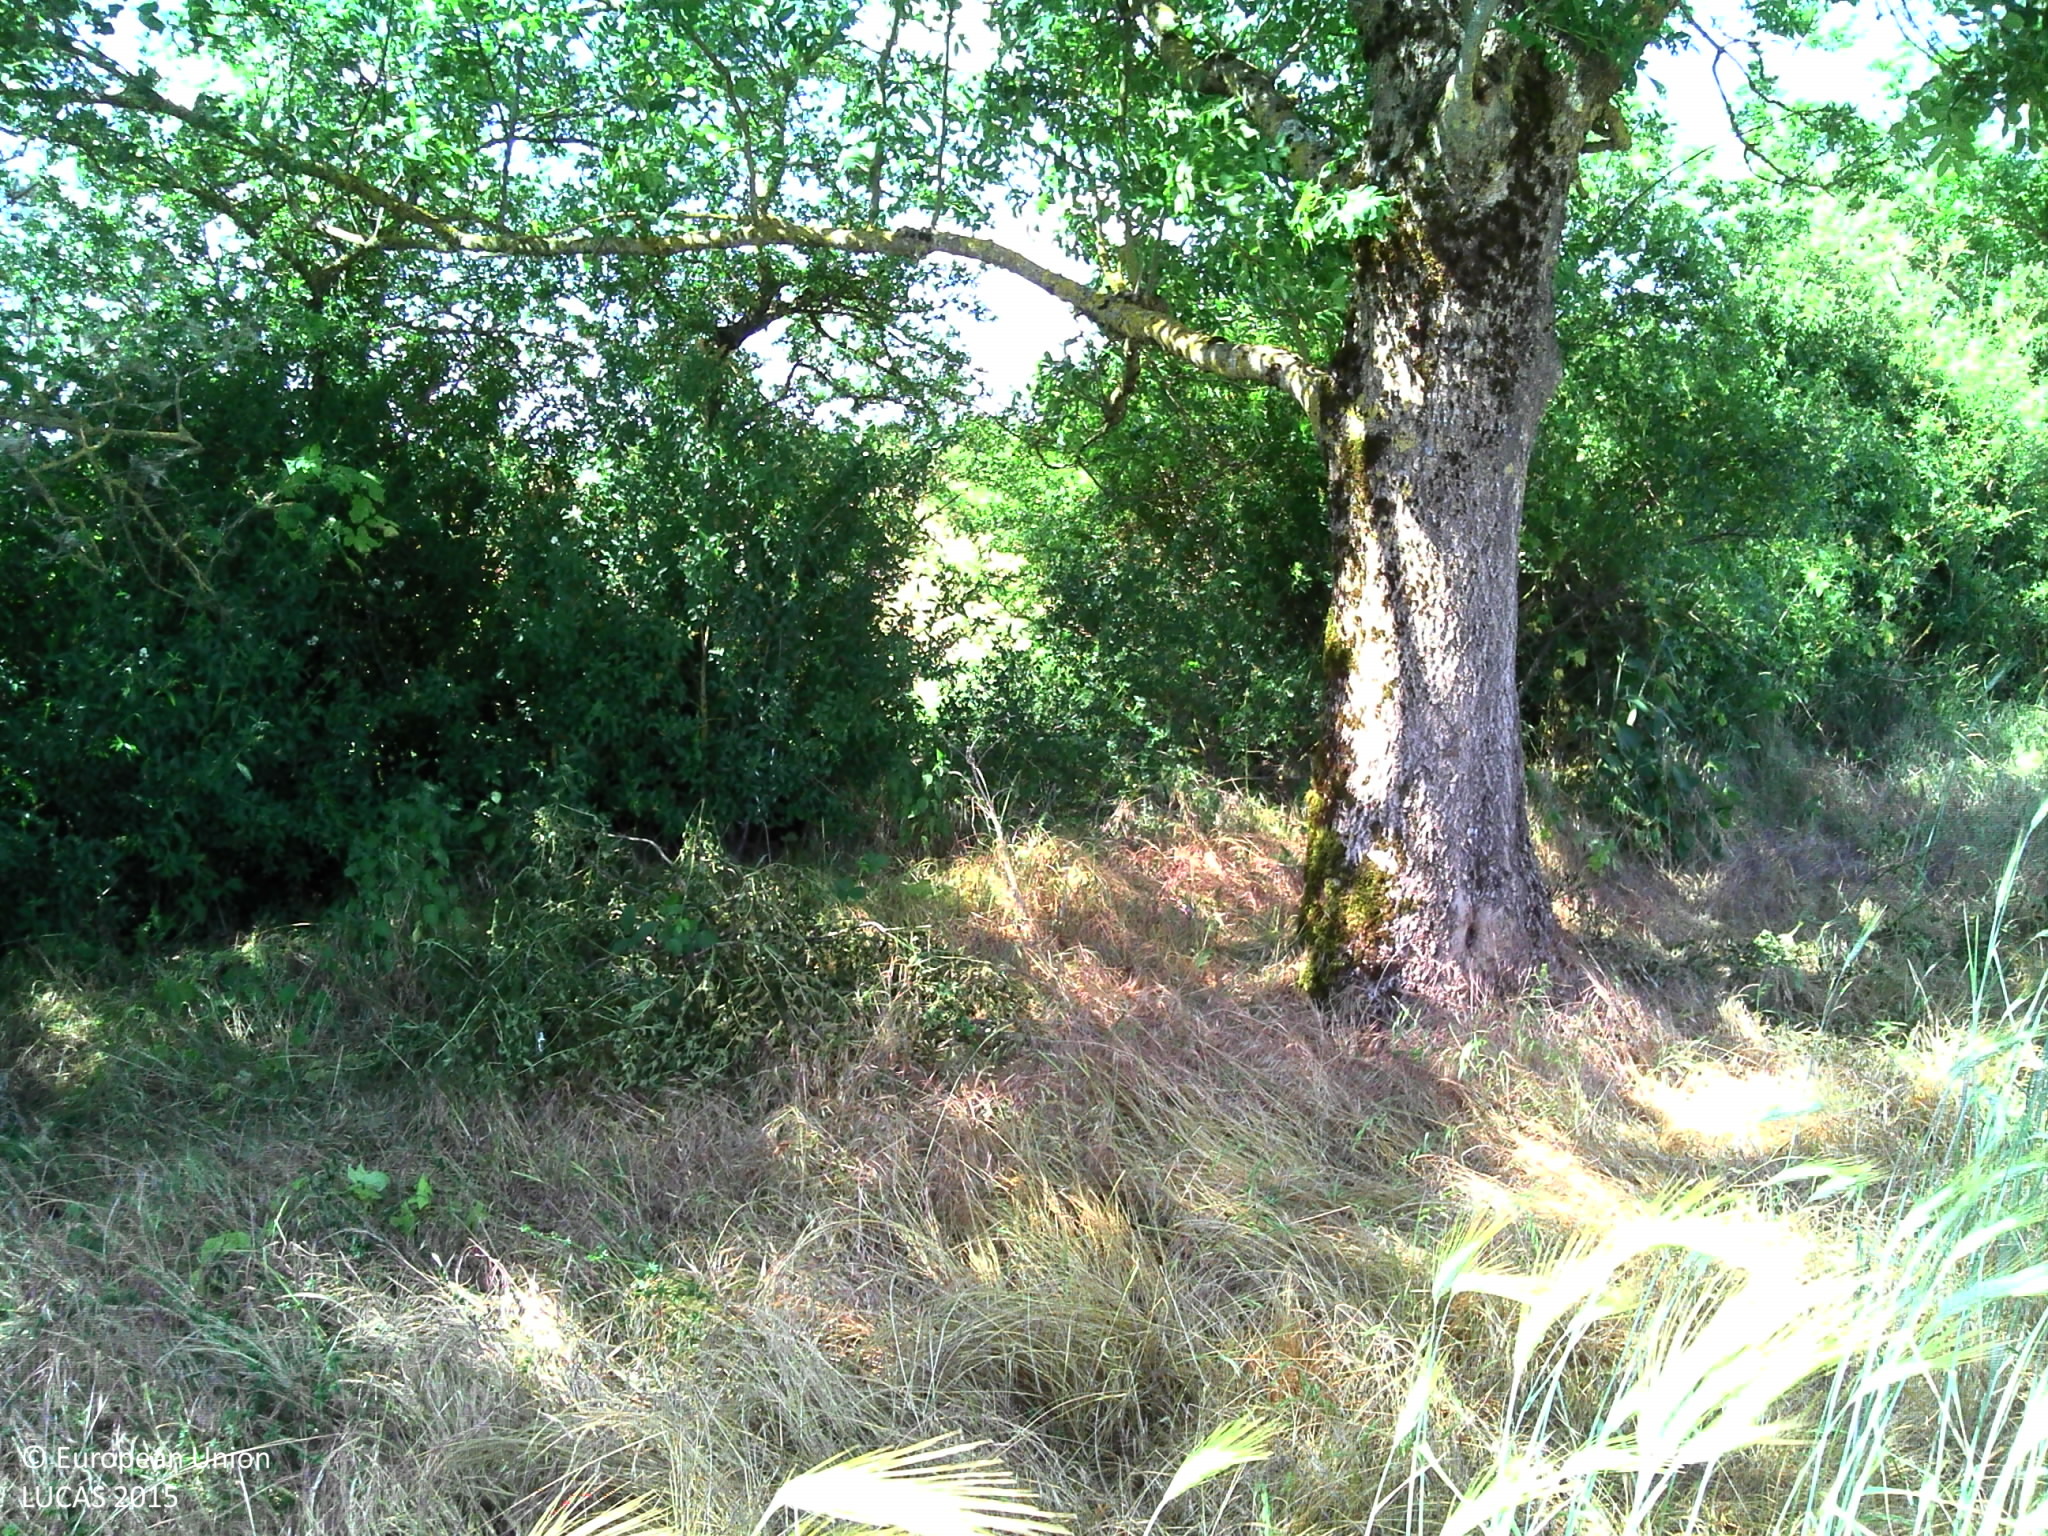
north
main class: Cropland
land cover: Triticale
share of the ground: > 75 %
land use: Agriculture (excluding fallow land and kitchen gardens)
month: June
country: FR
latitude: 44.4035
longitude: 2.4816
